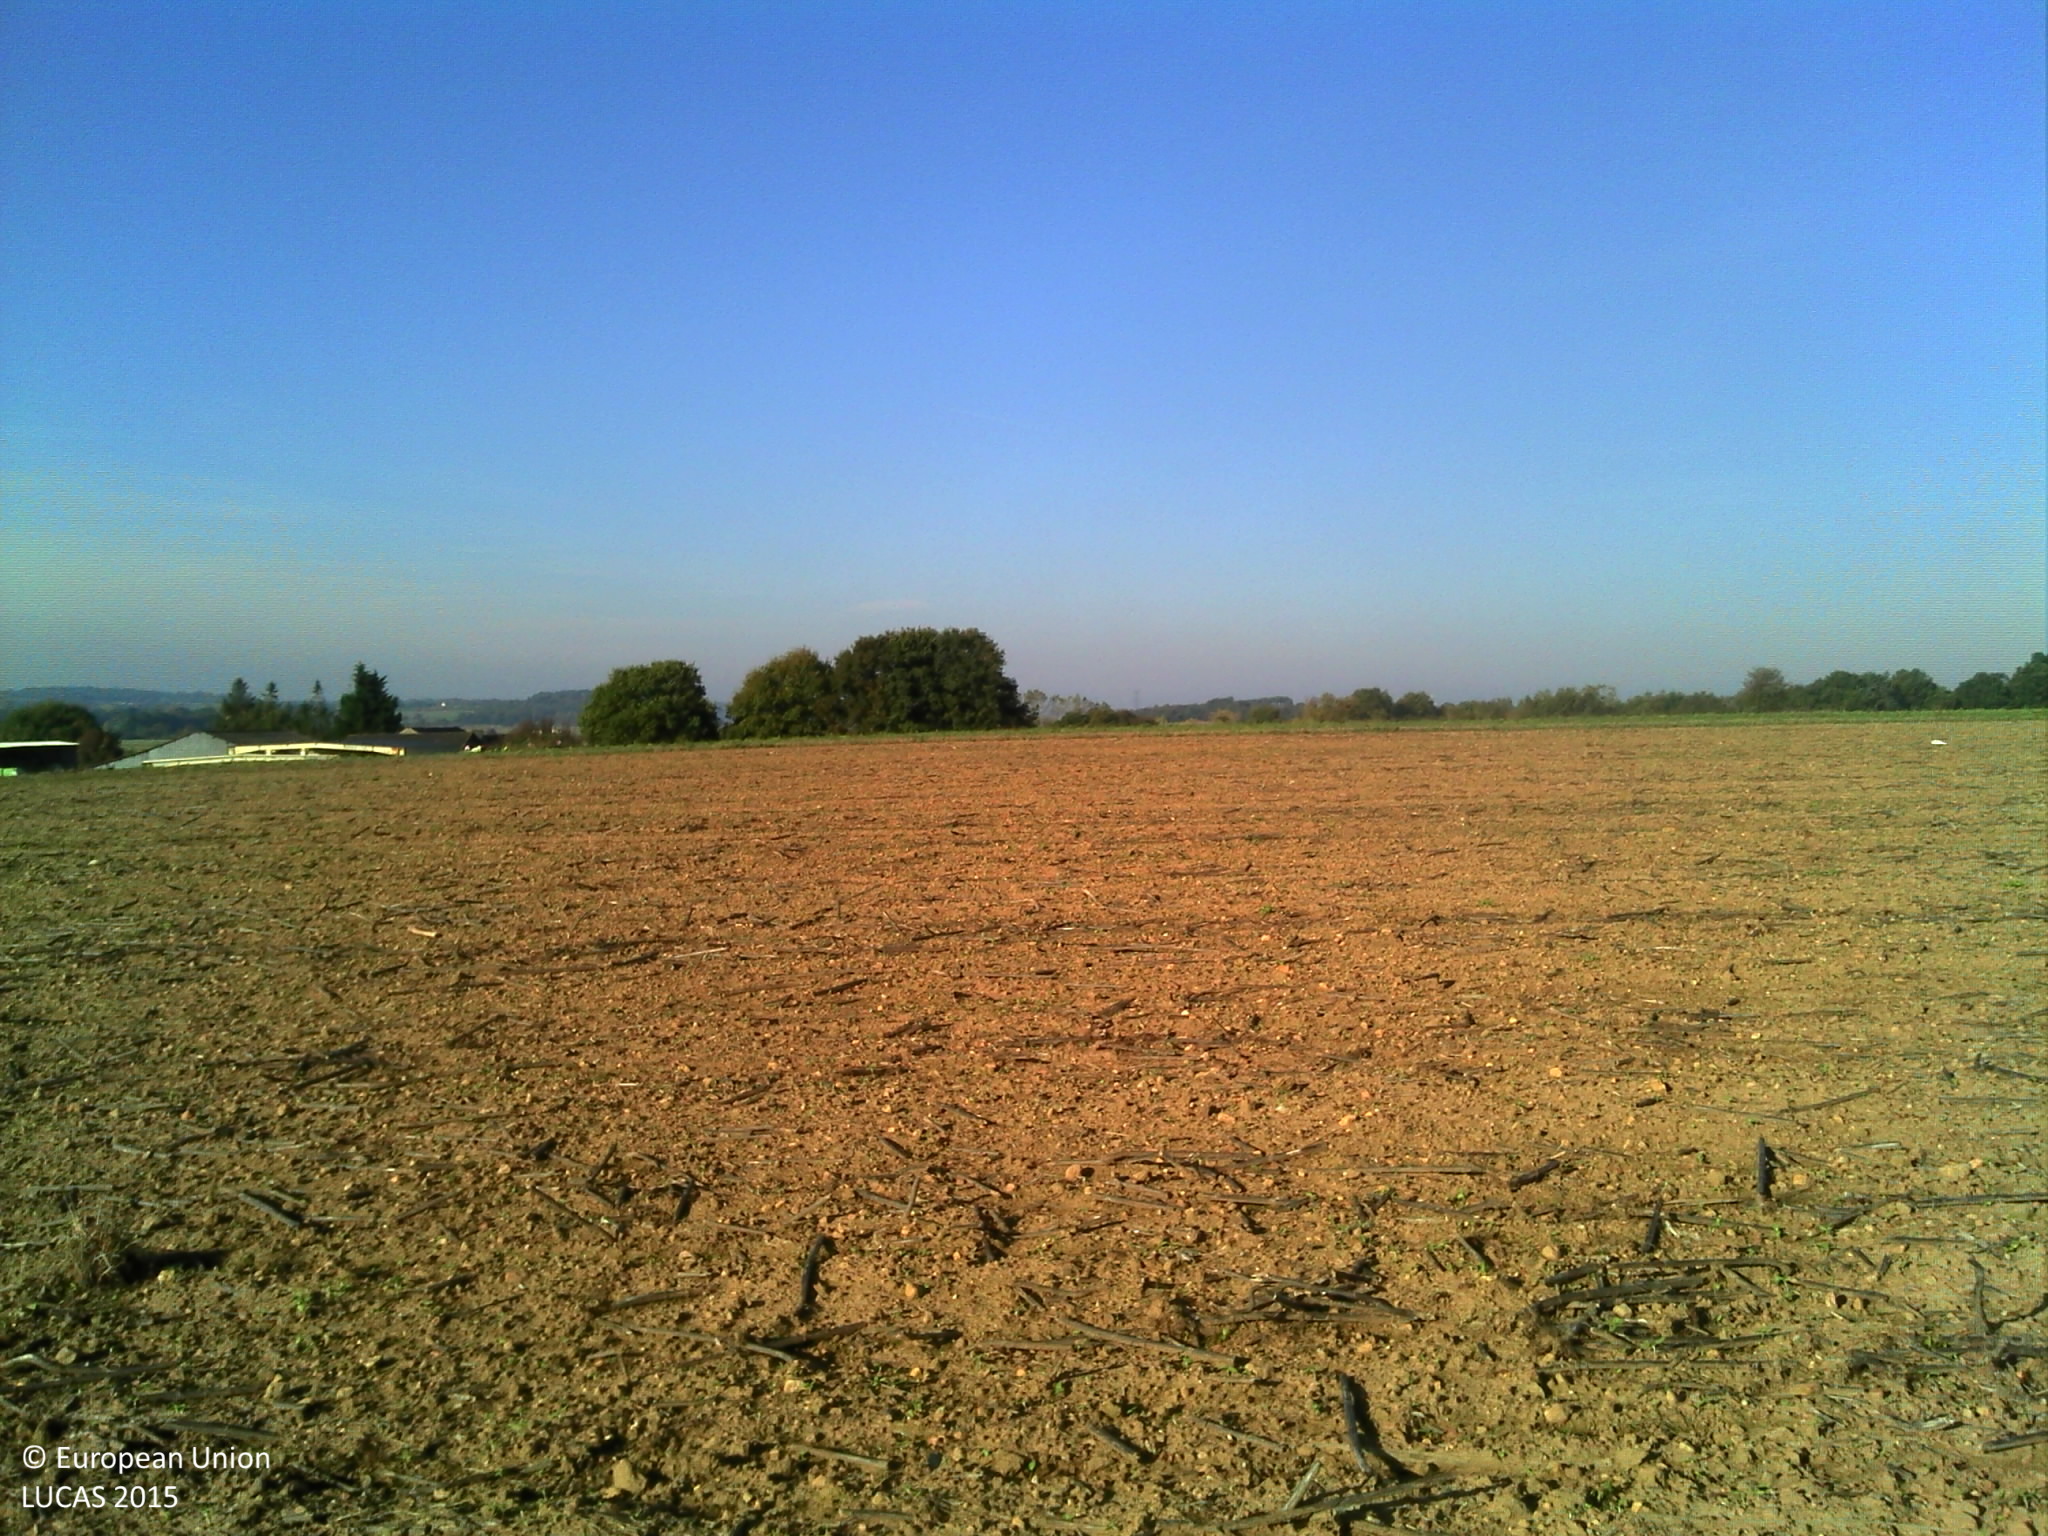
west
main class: Cropland
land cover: Sunflower
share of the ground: < 10 %
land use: Agriculture (excluding fallow land and kitchen gardens)
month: October
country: FR
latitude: 47.5892
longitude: -2.1127
